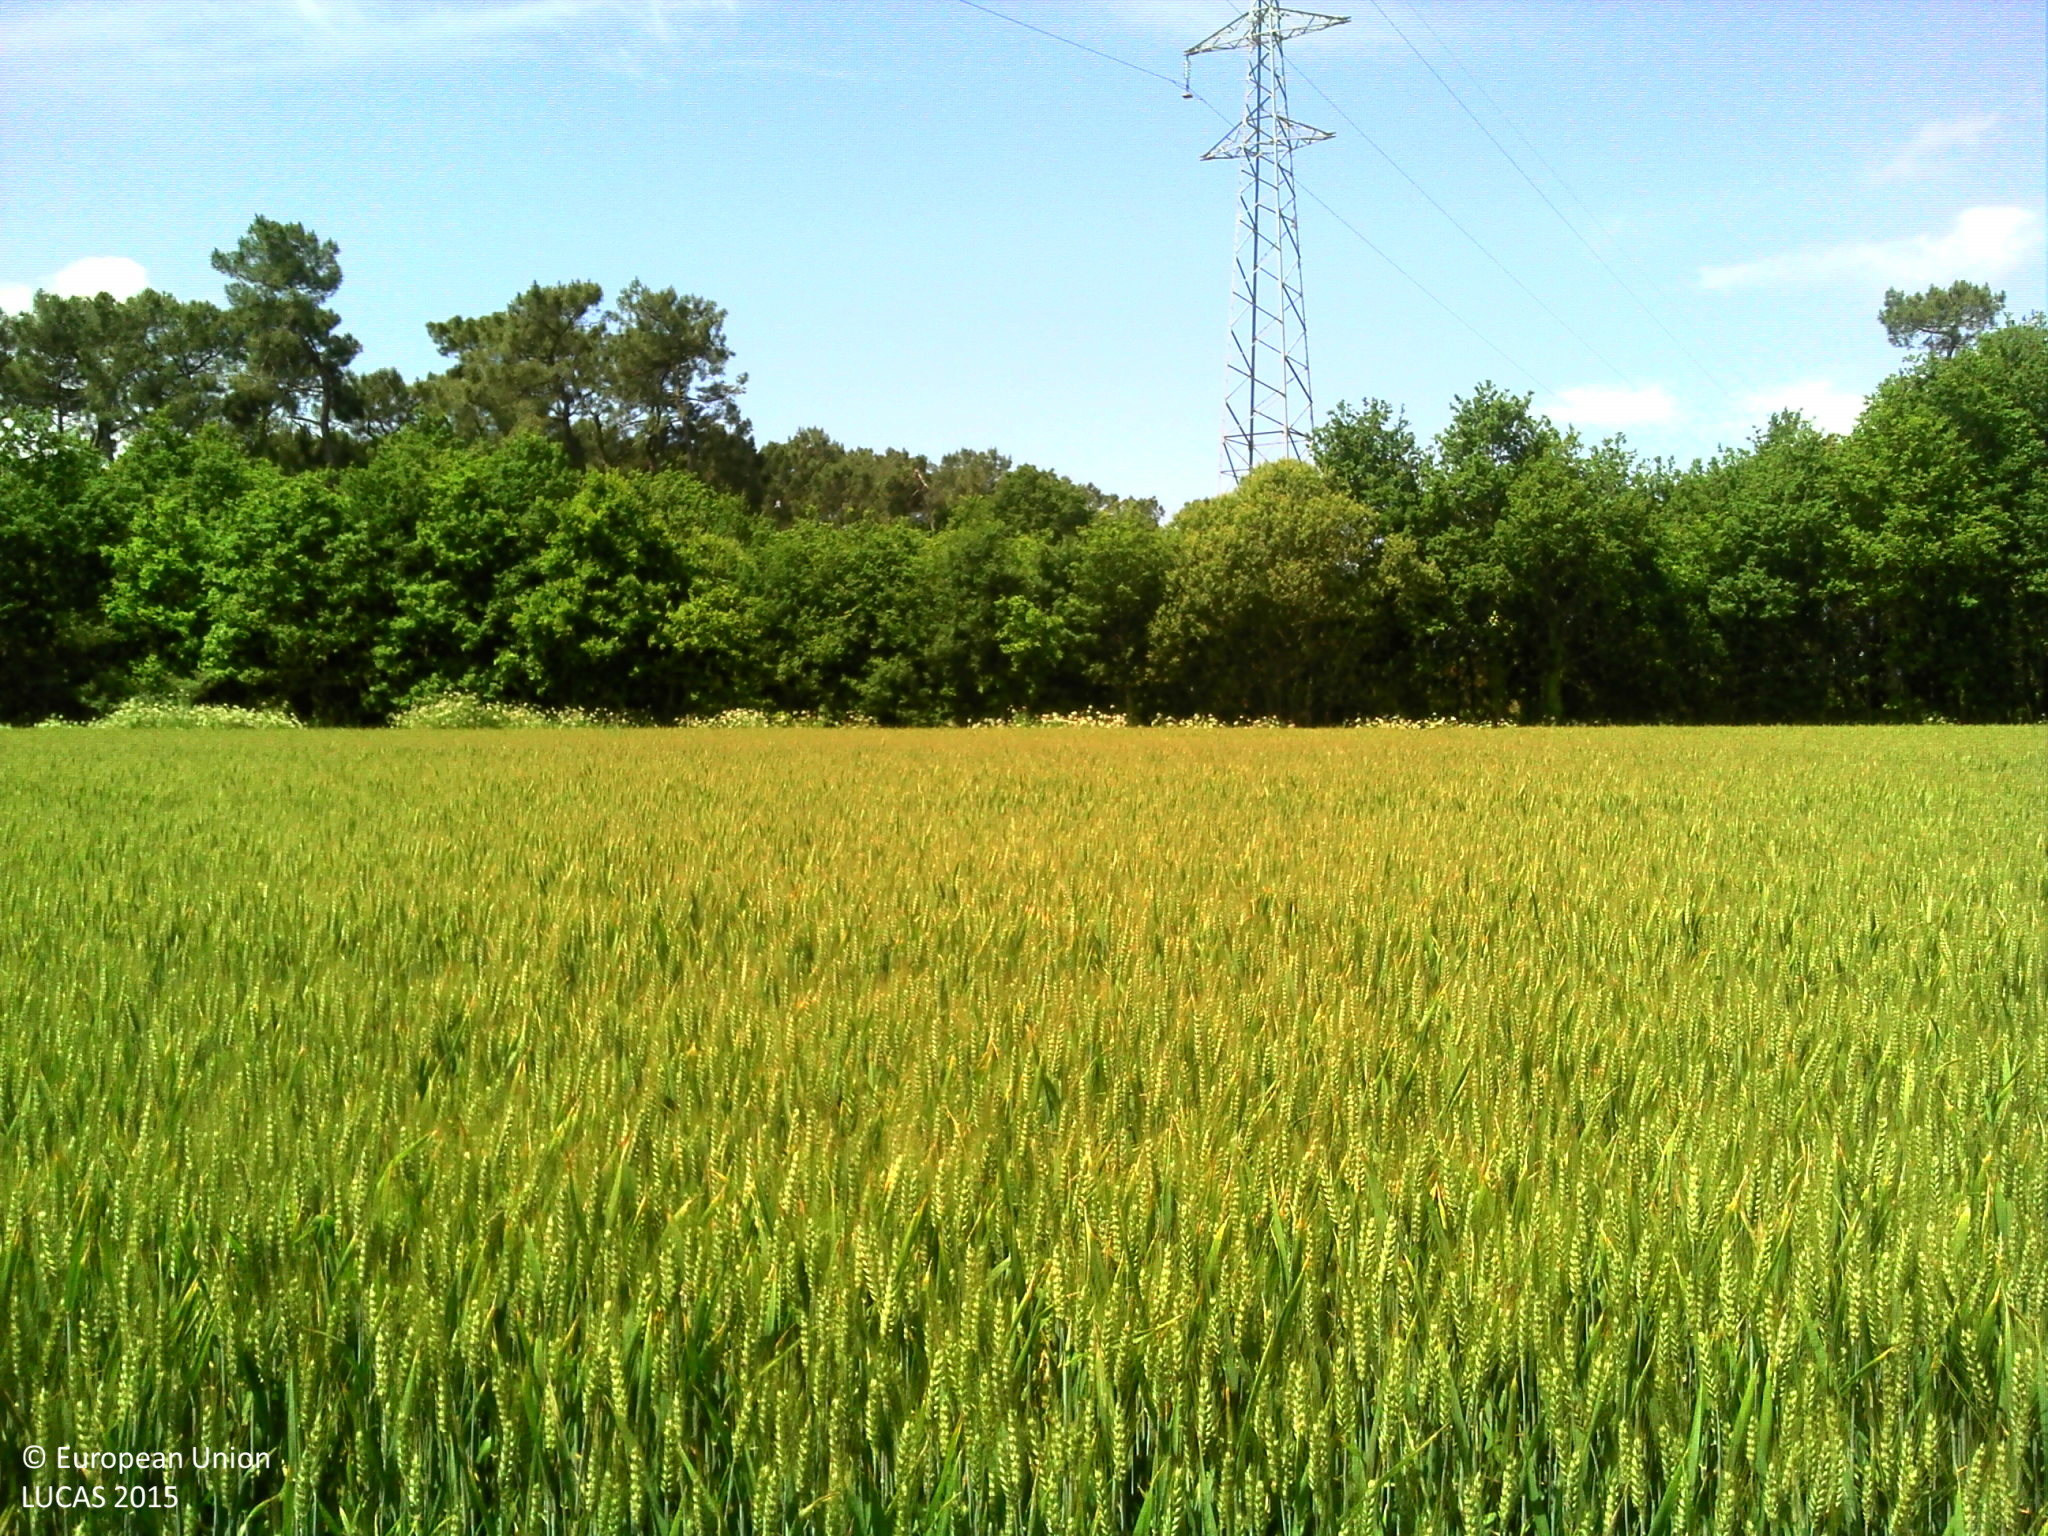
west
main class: Cropland
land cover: Common wheat
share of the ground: > 75 %
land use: Agriculture (excluding fallow land and kitchen gardens)
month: June
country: FR
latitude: 46.9154
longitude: -1.9553
